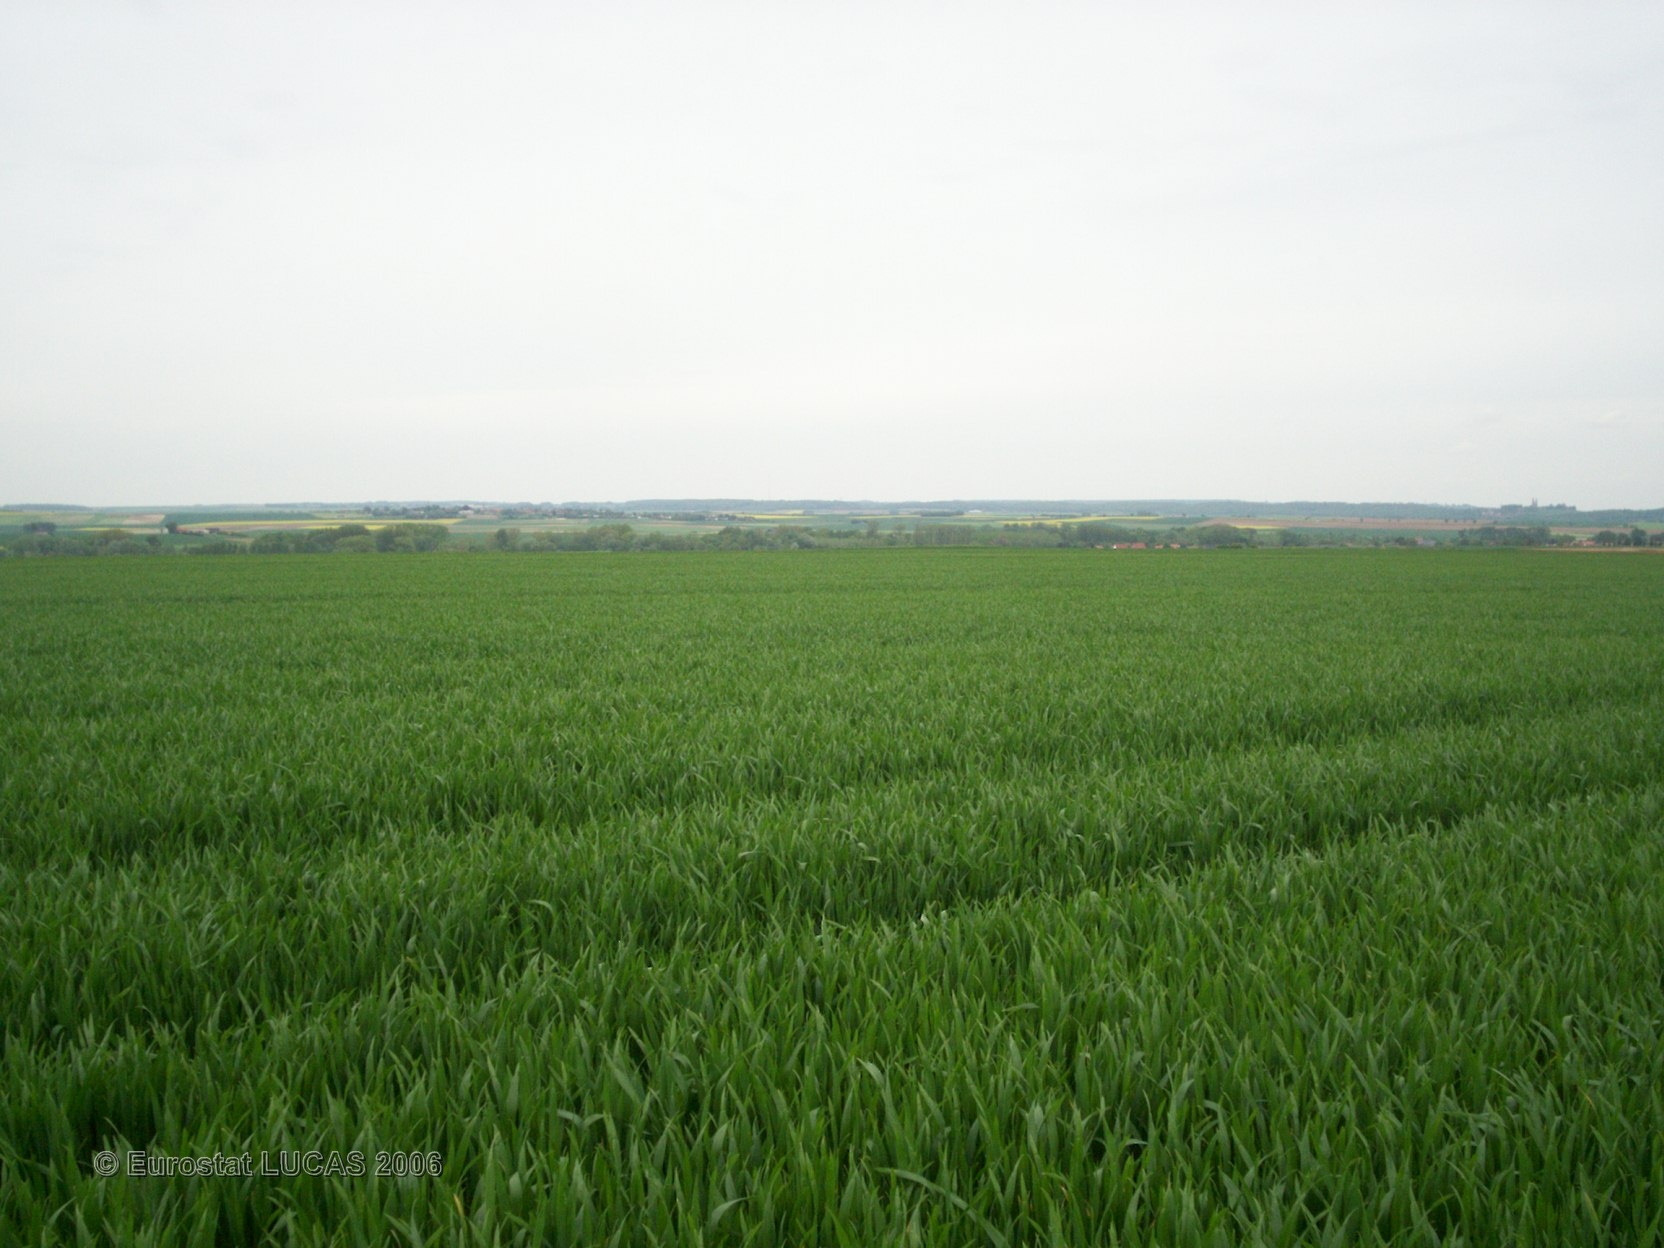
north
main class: Cropland
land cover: Common wheat
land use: Agriculture (excluding fallow land and kitchen gardens)
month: May
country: FR
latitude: 50.2898
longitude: 2.6475
